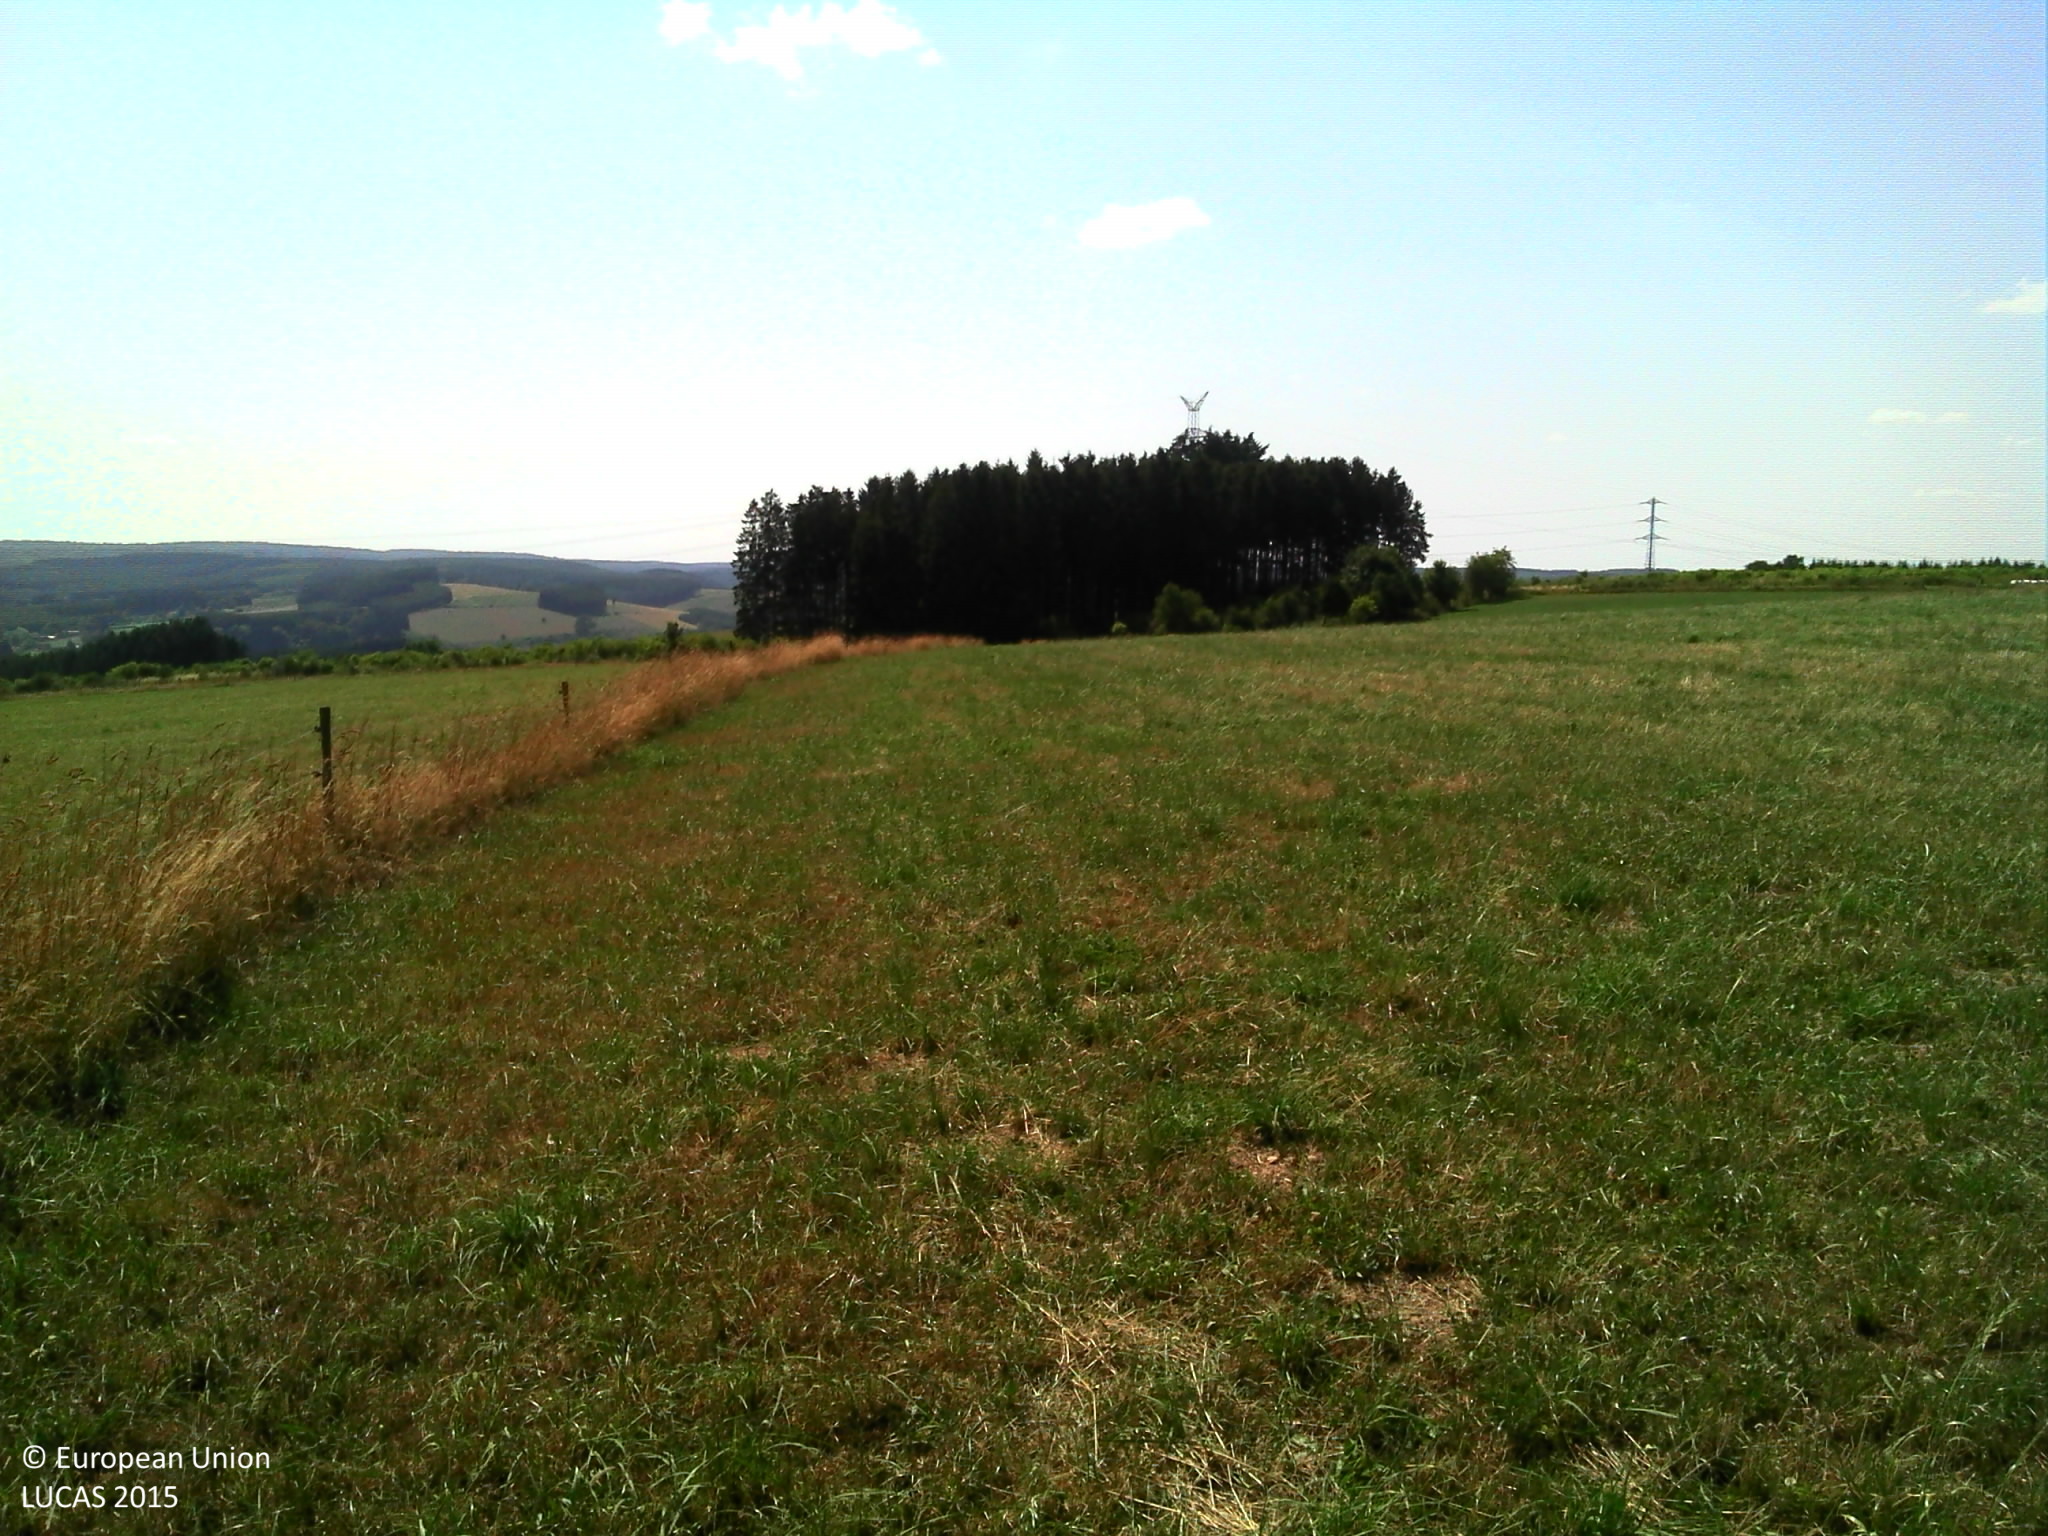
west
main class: Grassland
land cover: Grassland without tree/shrub cover
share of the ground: > 75 %
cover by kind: herbaceous plants 100 %
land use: Agriculture (excluding fallow land and kitchen gardens)
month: July
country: BE
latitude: 49.8522
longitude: 5.7289
